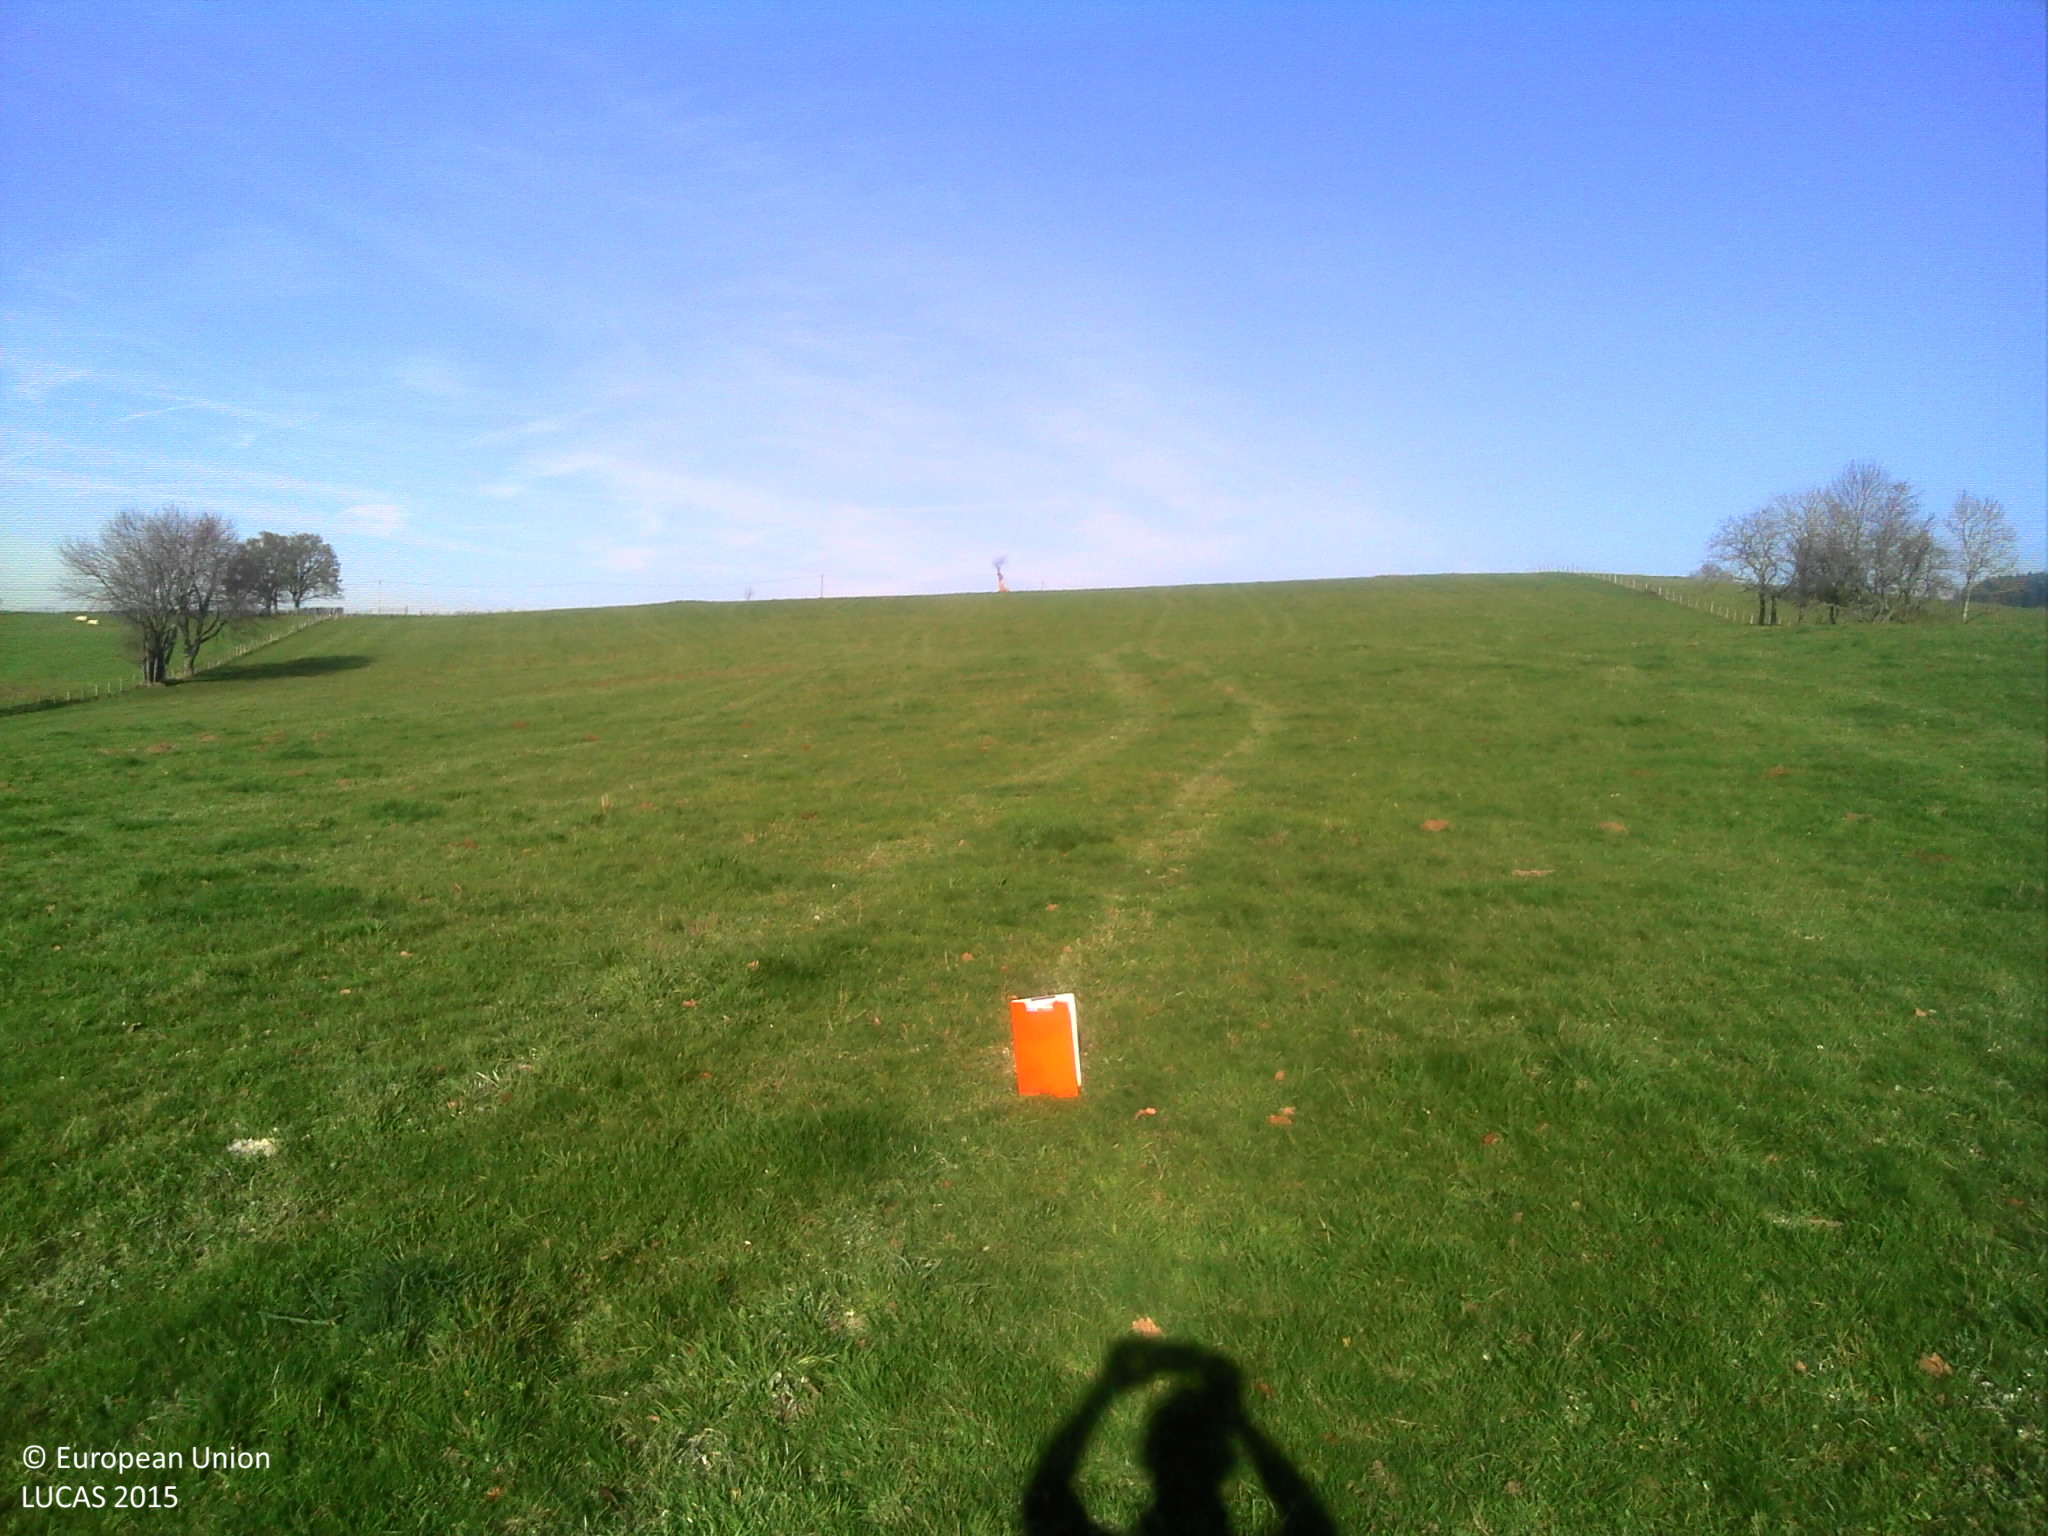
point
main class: Grassland
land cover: Grassland without tree/shrub cover
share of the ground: > 75 %
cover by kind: herbaceous plants 100 %
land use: Agriculture (excluding fallow land and kitchen gardens)
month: November
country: FR
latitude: 46.1292
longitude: 3.6974
